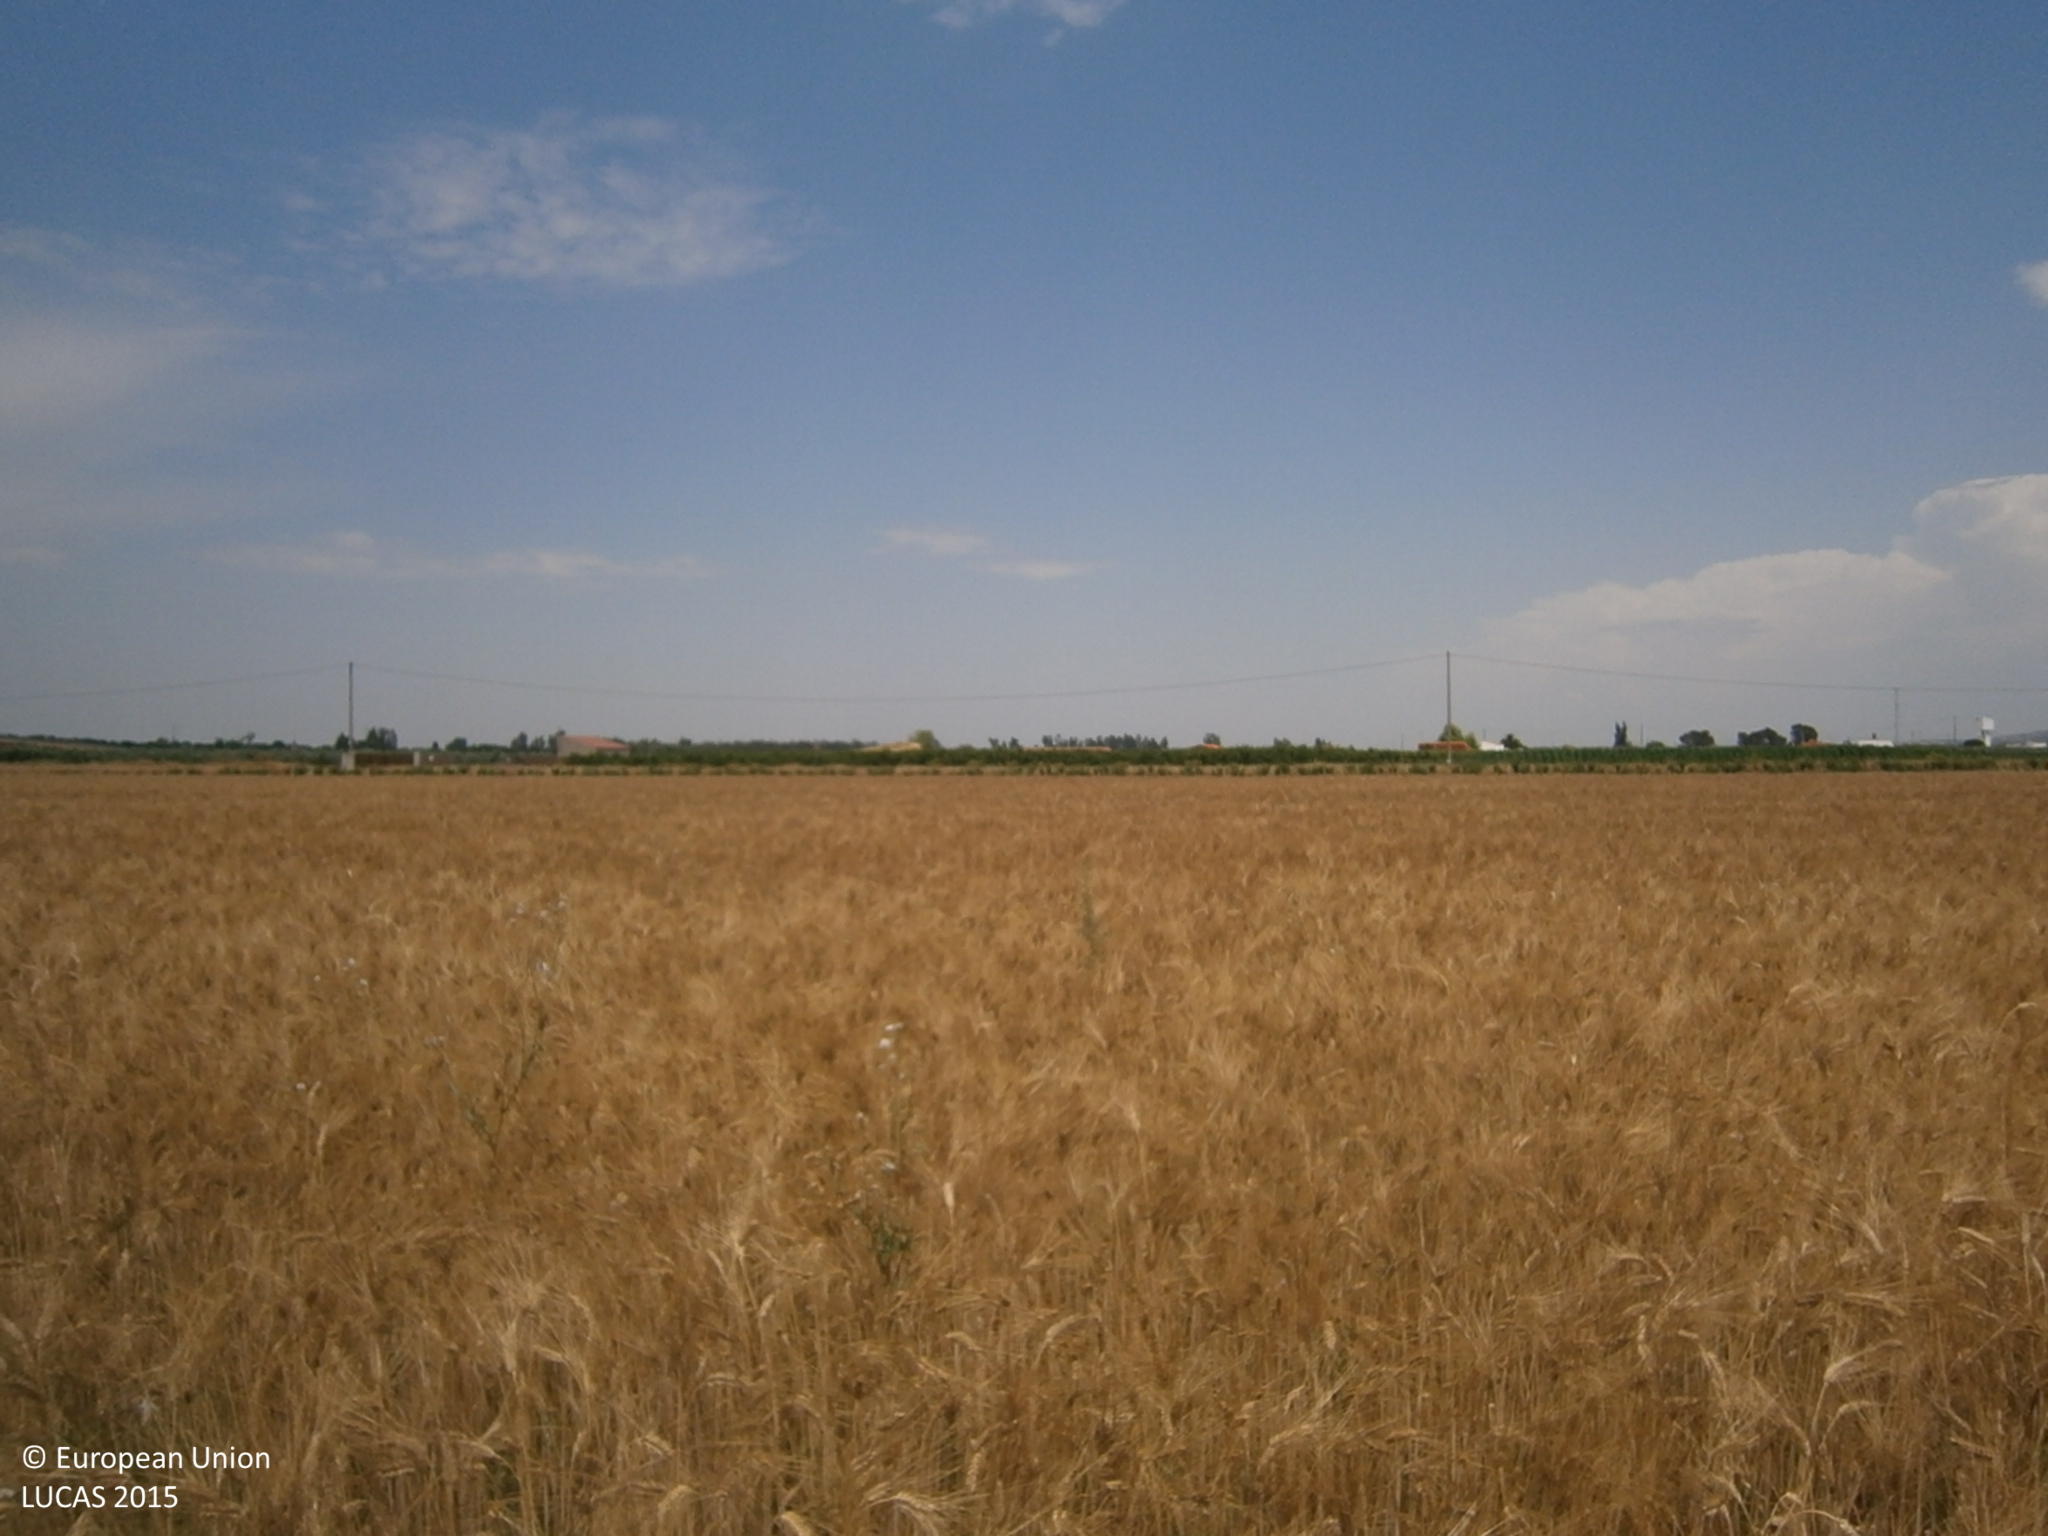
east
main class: Cropland
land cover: Durum wheat
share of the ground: > 75 %
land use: Agriculture (excluding fallow land and kitchen gardens)
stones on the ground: < 10 %
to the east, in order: Durum wheat; Other fruit trees and berries; Paved roads, cycling and walking lanes; Electric lines; Other fruit trees and berries
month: June
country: ES
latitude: 38.9077
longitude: -6.5403
